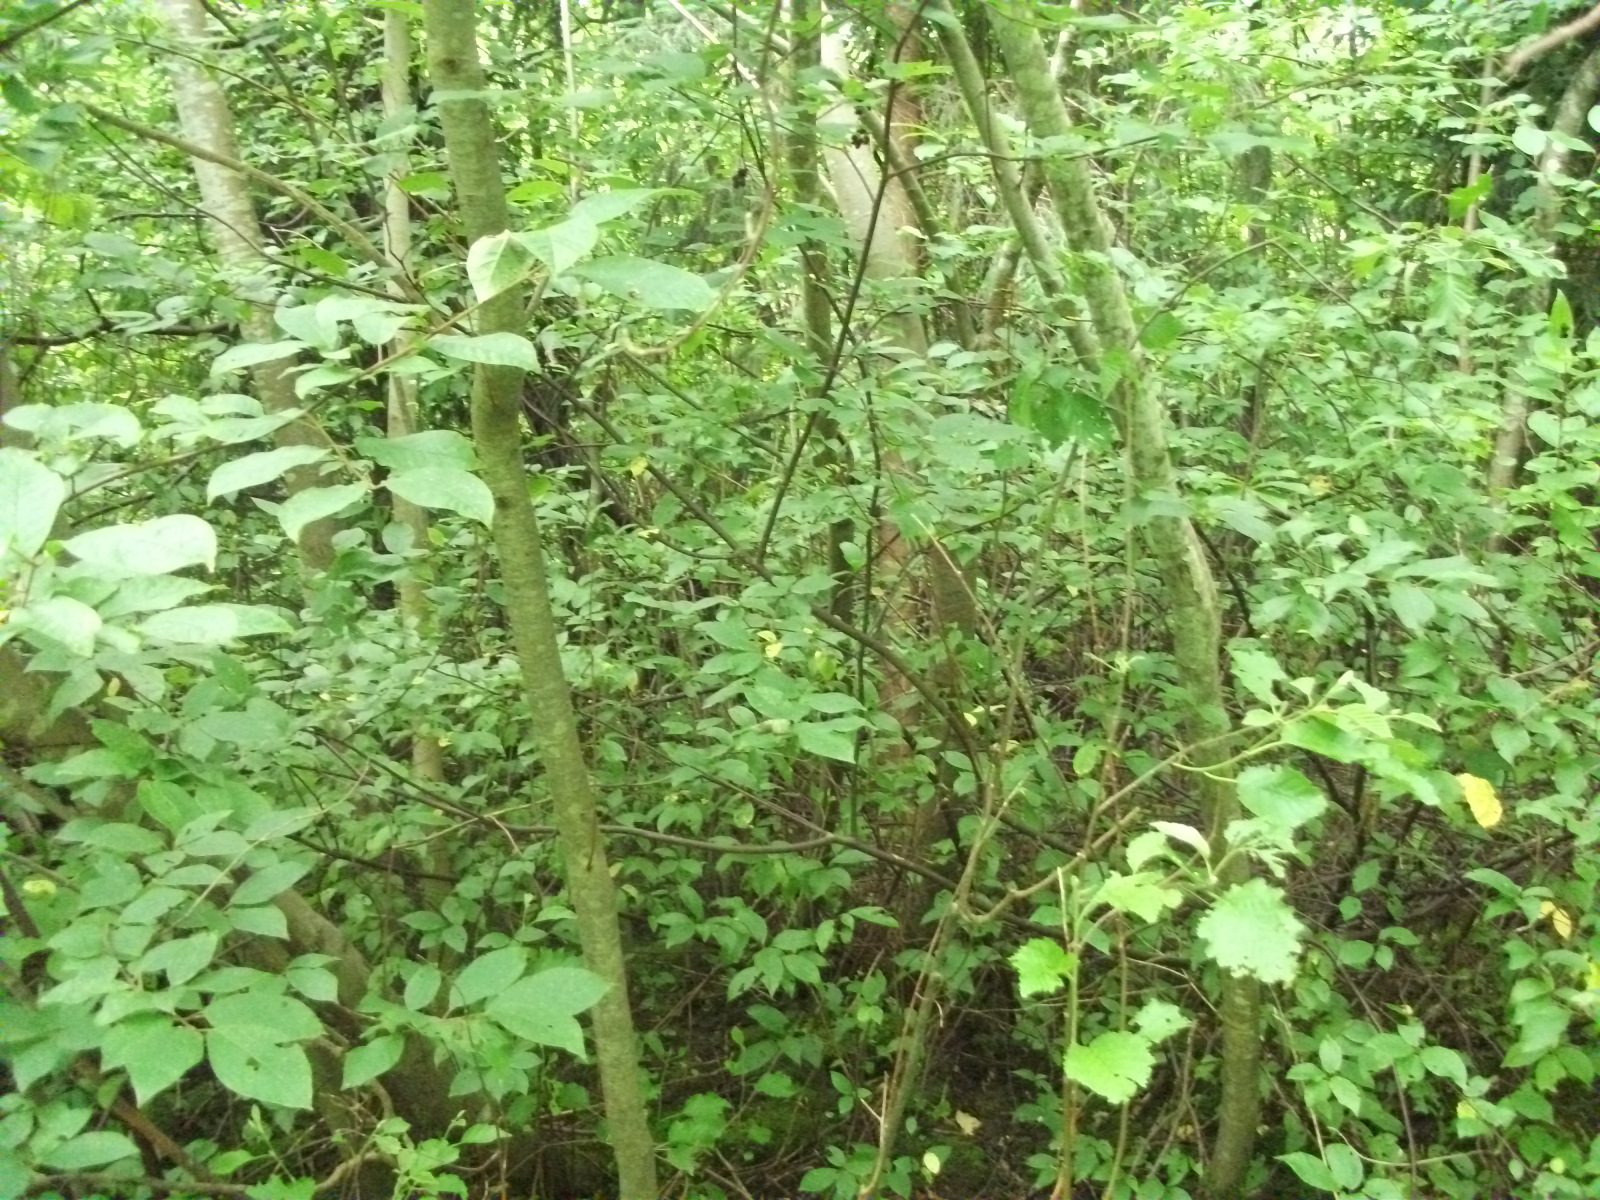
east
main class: Woodland
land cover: Broadleaved woodland
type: non-riverine alder, birch or aspen forest
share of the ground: > 75 %
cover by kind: broadleaved forest trees 90 %, herbaceous plants 10 %
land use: Forestry
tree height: > 5 m
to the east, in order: Broadleaved woodland; Grassland without tree/shrub cover; Broadleaved woodland; Grassland without tree/shrub cover
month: July
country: LV
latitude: 56.9946
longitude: 26.2868
